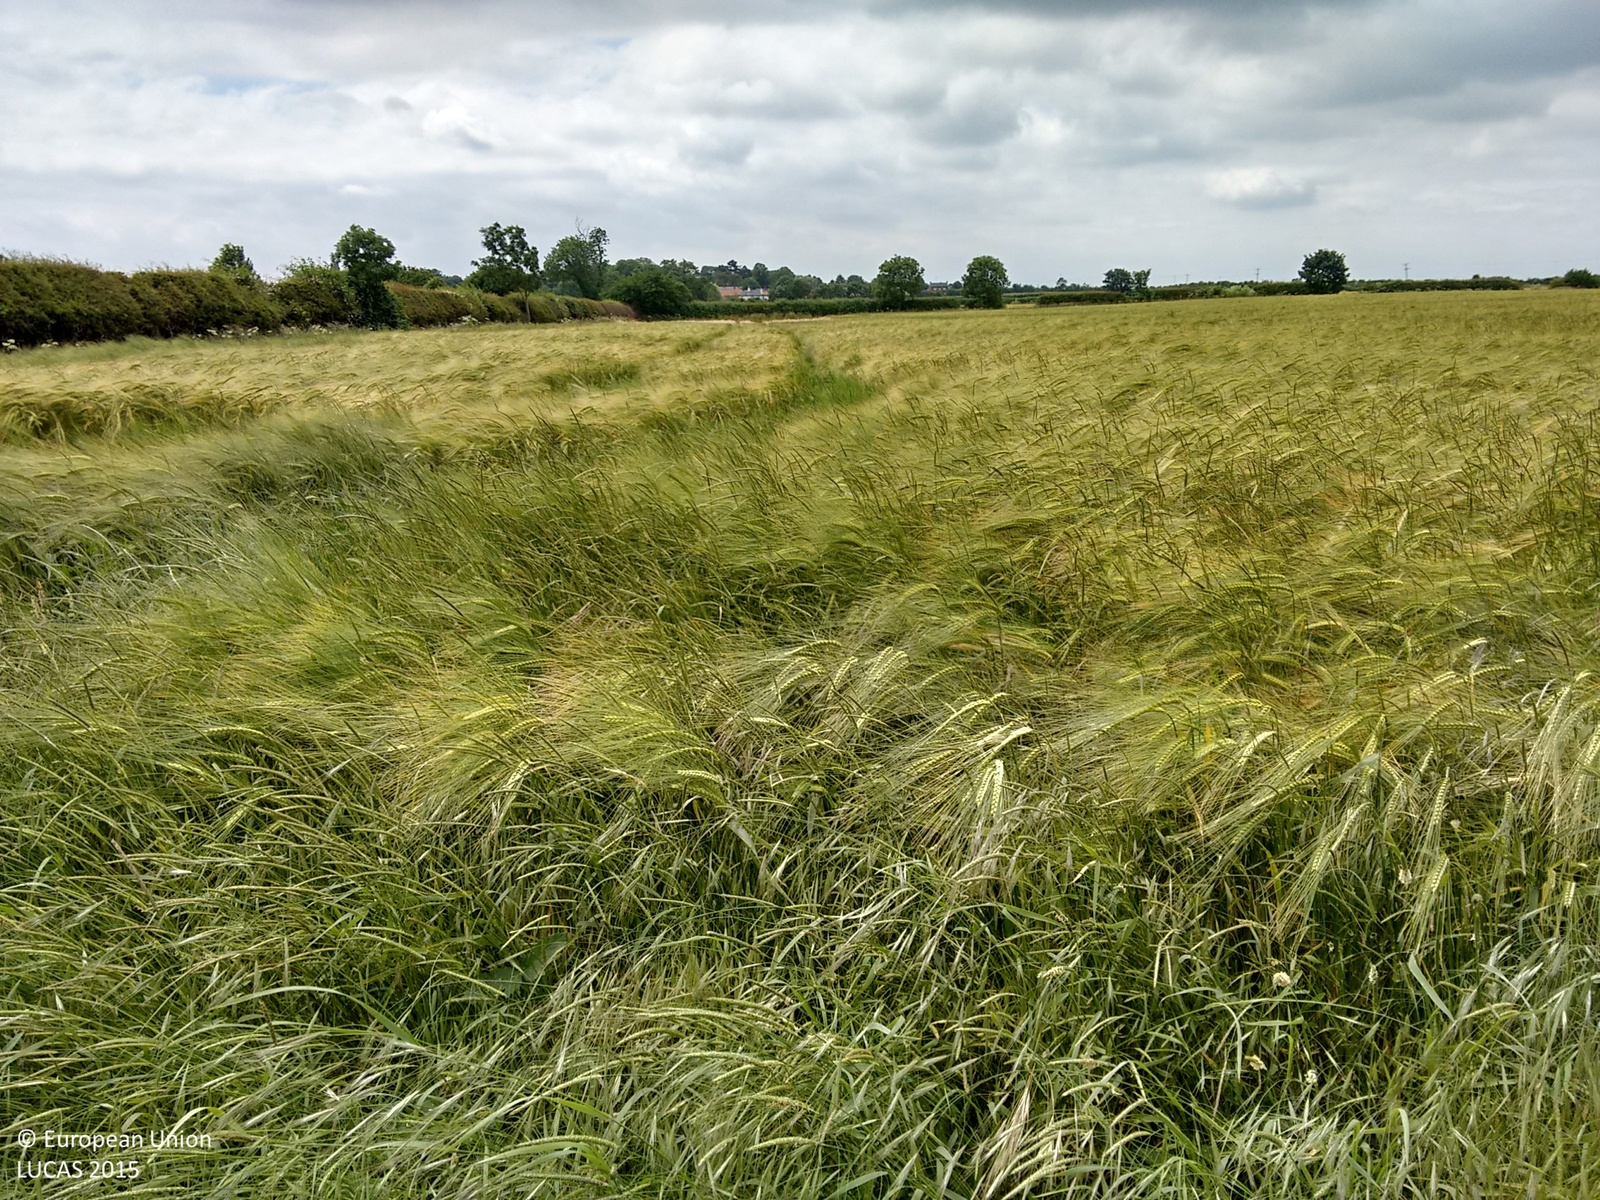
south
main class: Cropland
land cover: Barley
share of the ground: > 75 %
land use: Agriculture (excluding fallow land and kitchen gardens)
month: June
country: GB
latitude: 52.9481
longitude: -0.8619
